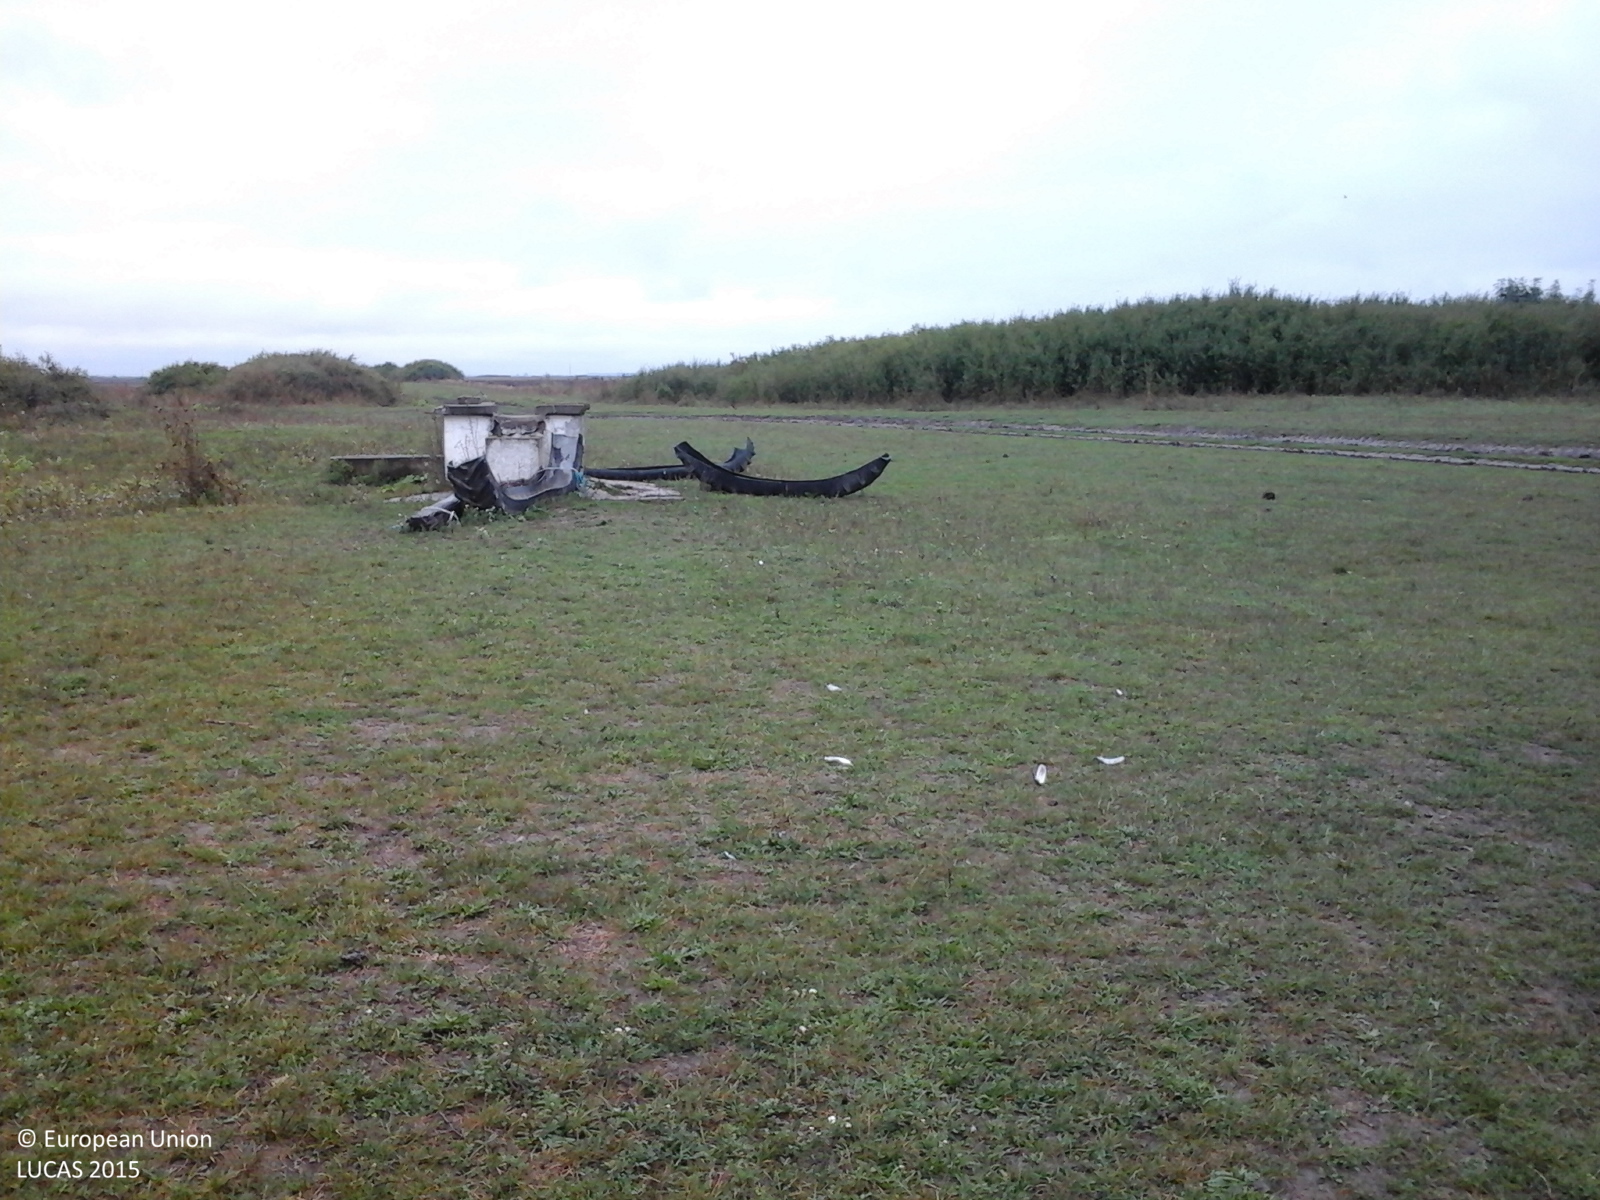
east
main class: Grassland
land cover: Grassland without tree/shrub cover
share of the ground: > 75 %
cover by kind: herbaceous plants 100 %
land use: Agriculture (excluding fallow land and kitchen gardens)
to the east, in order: Grassland without tree/shrub cover; Tracks; Grassland without tree/shrub cover; Shrubland without tree cover; Ditches and canals; Shrubland without tree cover; Common wheat
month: September
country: RO
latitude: 46.8758
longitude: 21.6536
